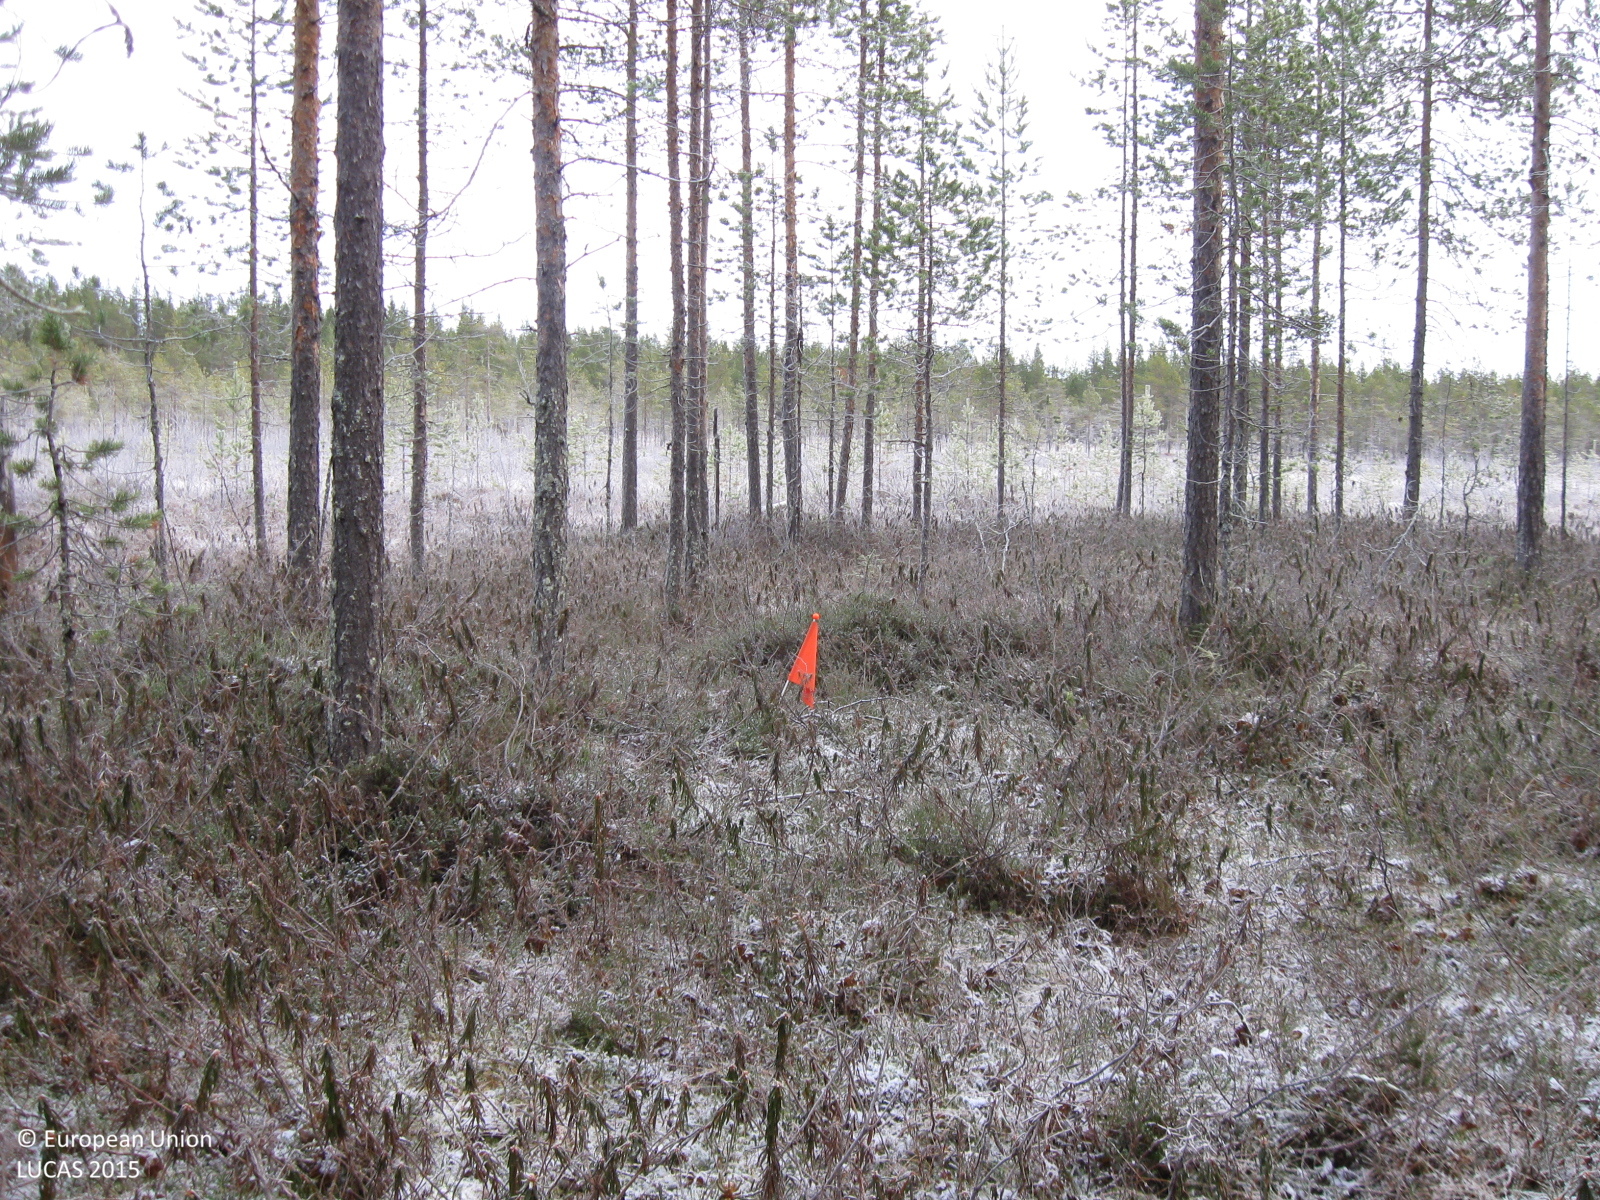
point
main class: Woodland
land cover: Pine dominated coniferous woodland
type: mire and swamp forests
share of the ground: 50 - 75 %
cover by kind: coniferous forest trees 55 %, shrubs 25 %, herbaceous plants 10 %, lichens and mosses 10 %
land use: Forestry
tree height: > 5 m
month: October
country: SE
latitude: 66.1146
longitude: 21.3198
